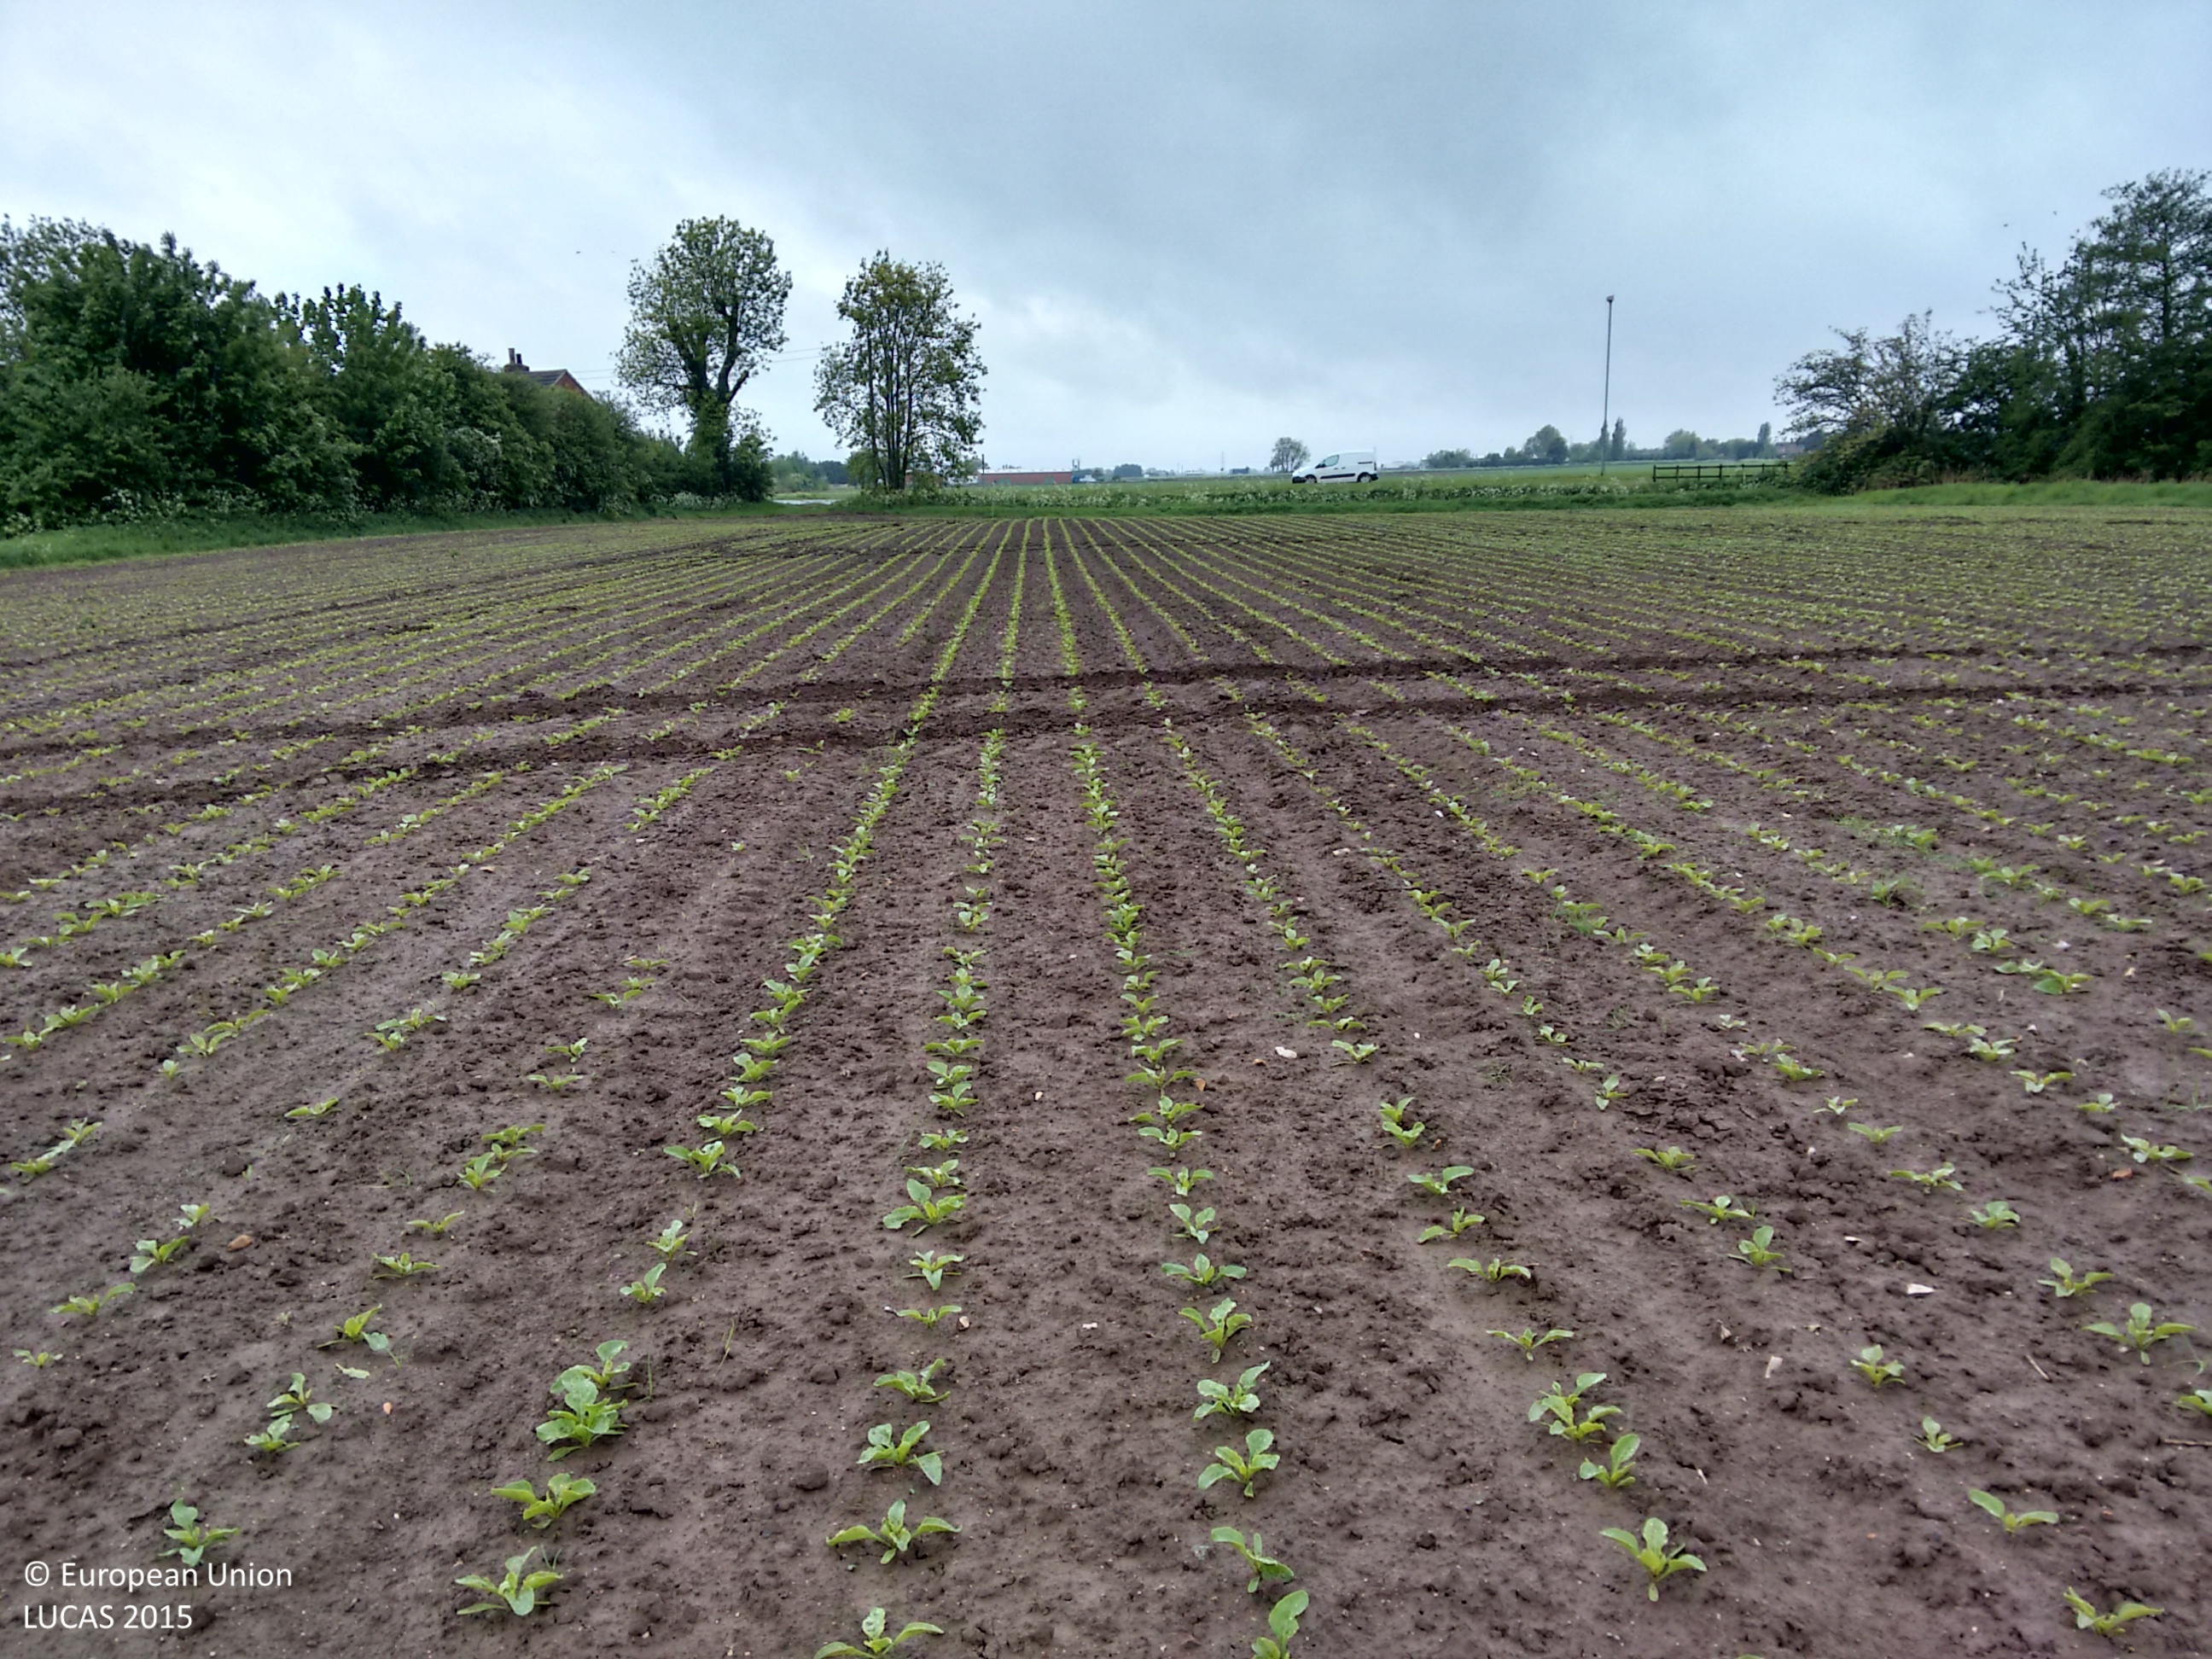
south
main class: Cropland
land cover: Sugar beet
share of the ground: < 10 %
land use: Agriculture (excluding fallow land and kitchen gardens)
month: May
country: GB
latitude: 52.9062
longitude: -0.0992
